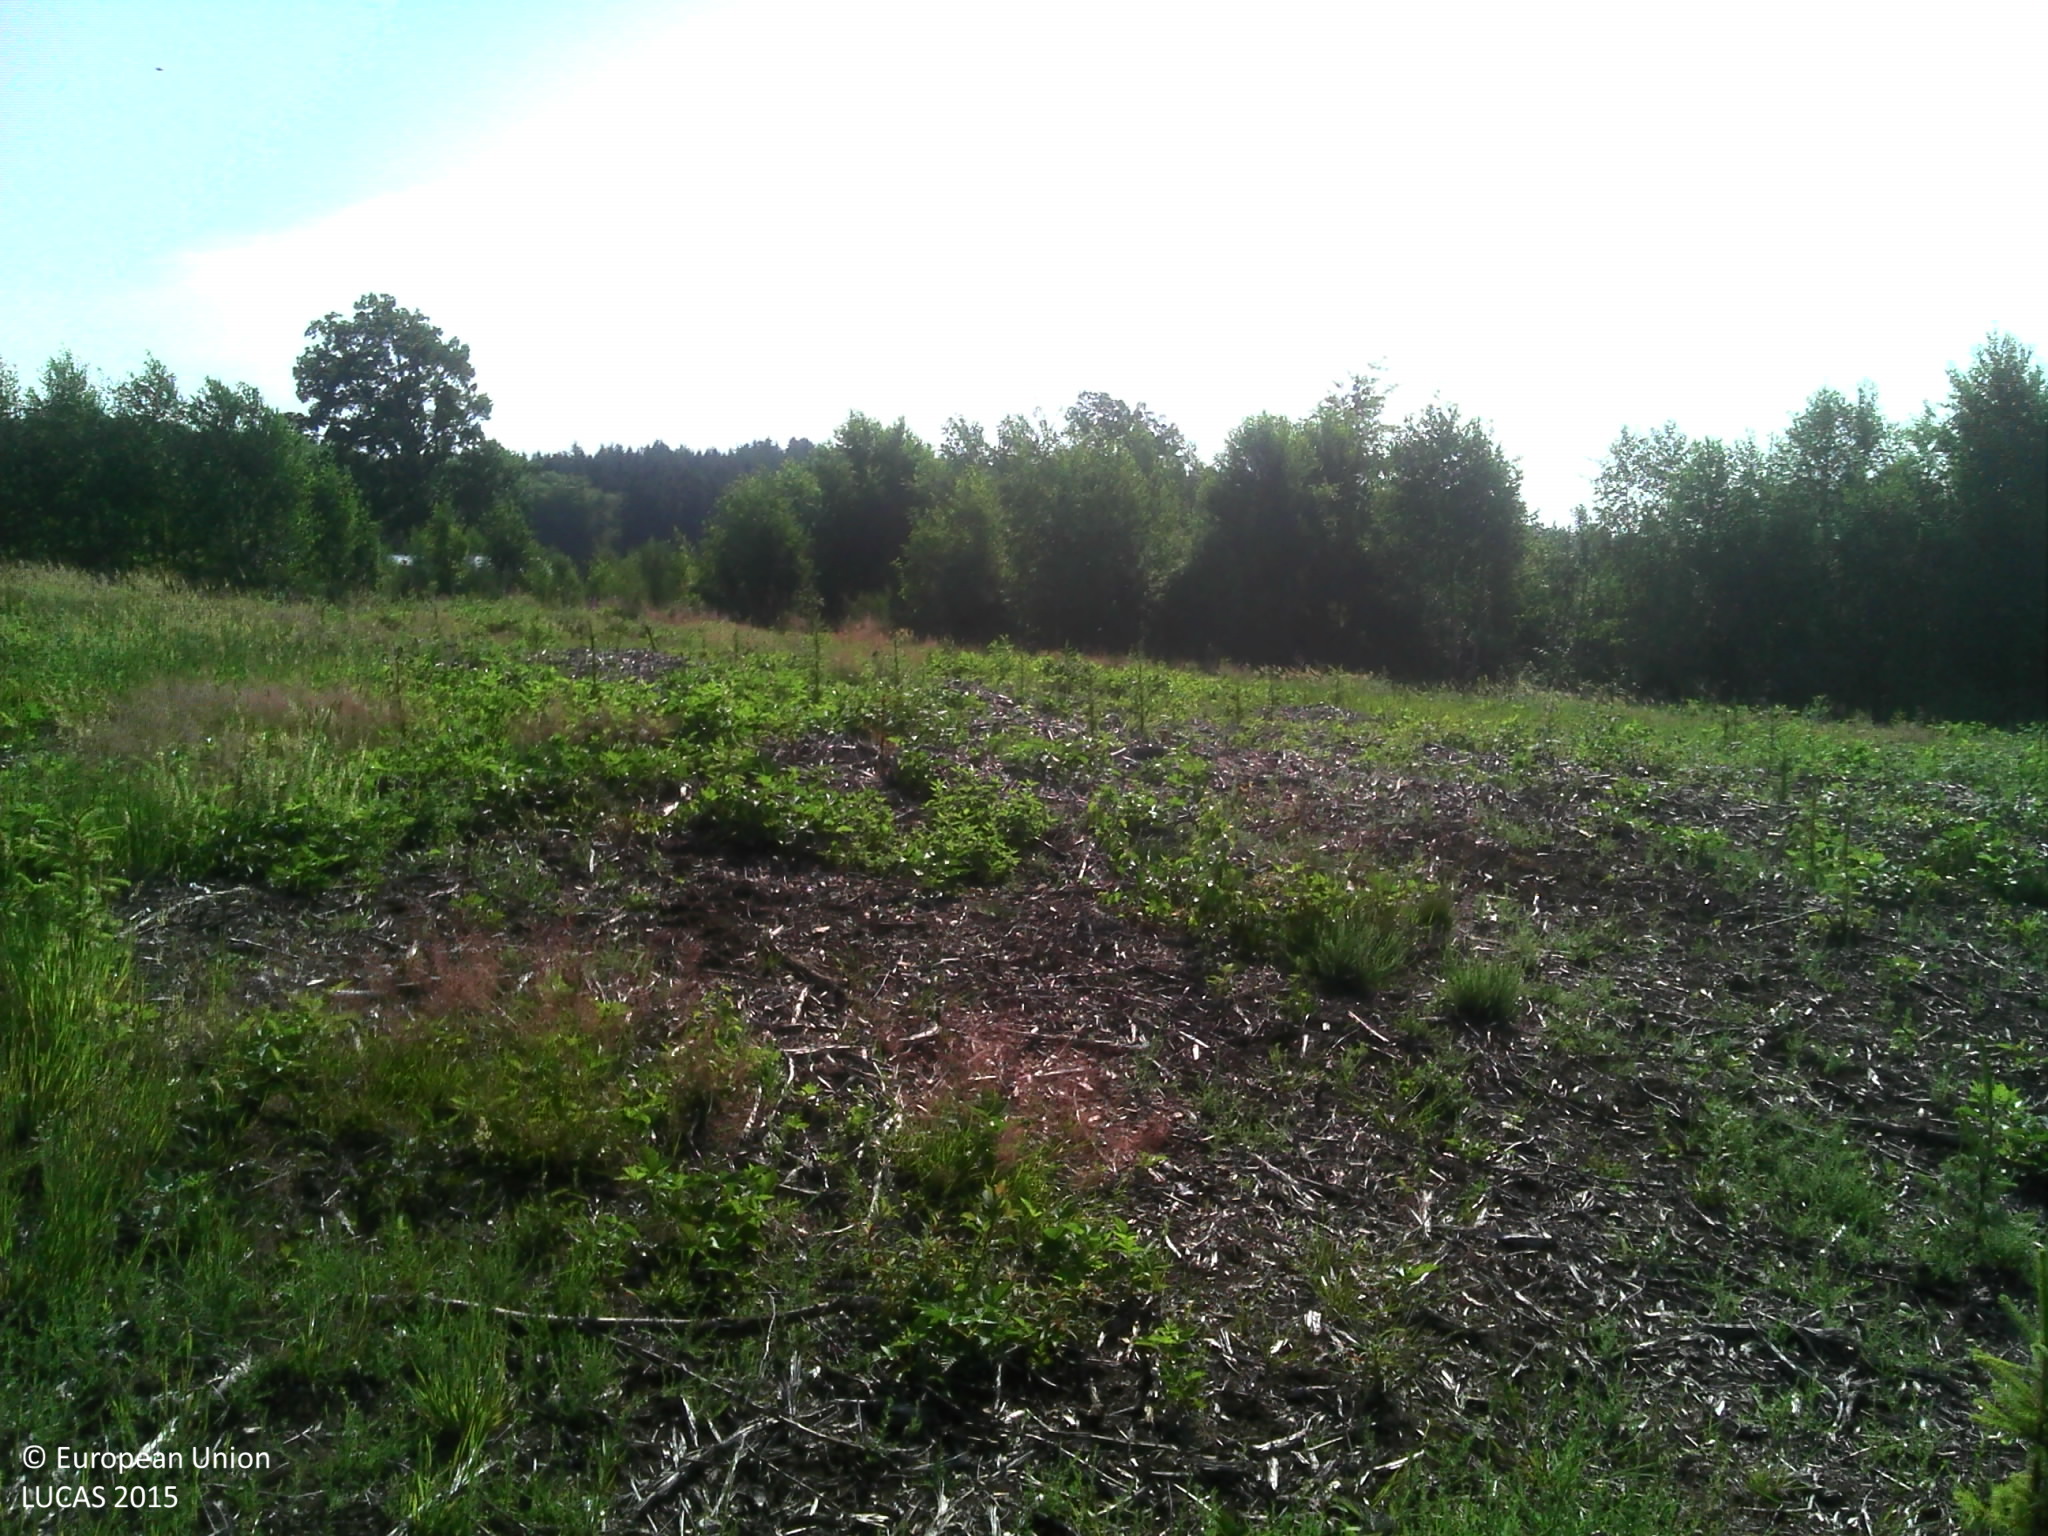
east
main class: Grassland
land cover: Spontaneously vegetated surfaces
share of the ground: 50 - 75 %
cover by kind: herbaceous plants 60 %, unconsolidated bare surface 35 %, shrubs 5 %
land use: Forestry
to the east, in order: Spontaneously vegetated surfaces; Broadleaved woodland; Tracks; Spontaneously vegetated surfaces; Paved roads, cycling and walking lanes; Broadleaved woodland; Grassland without tree/shrub cover; Tracks; Grass margins; Fences; Grassland without tree/shrub cover
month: July
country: BE
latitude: 49.9567
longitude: 5.6358
